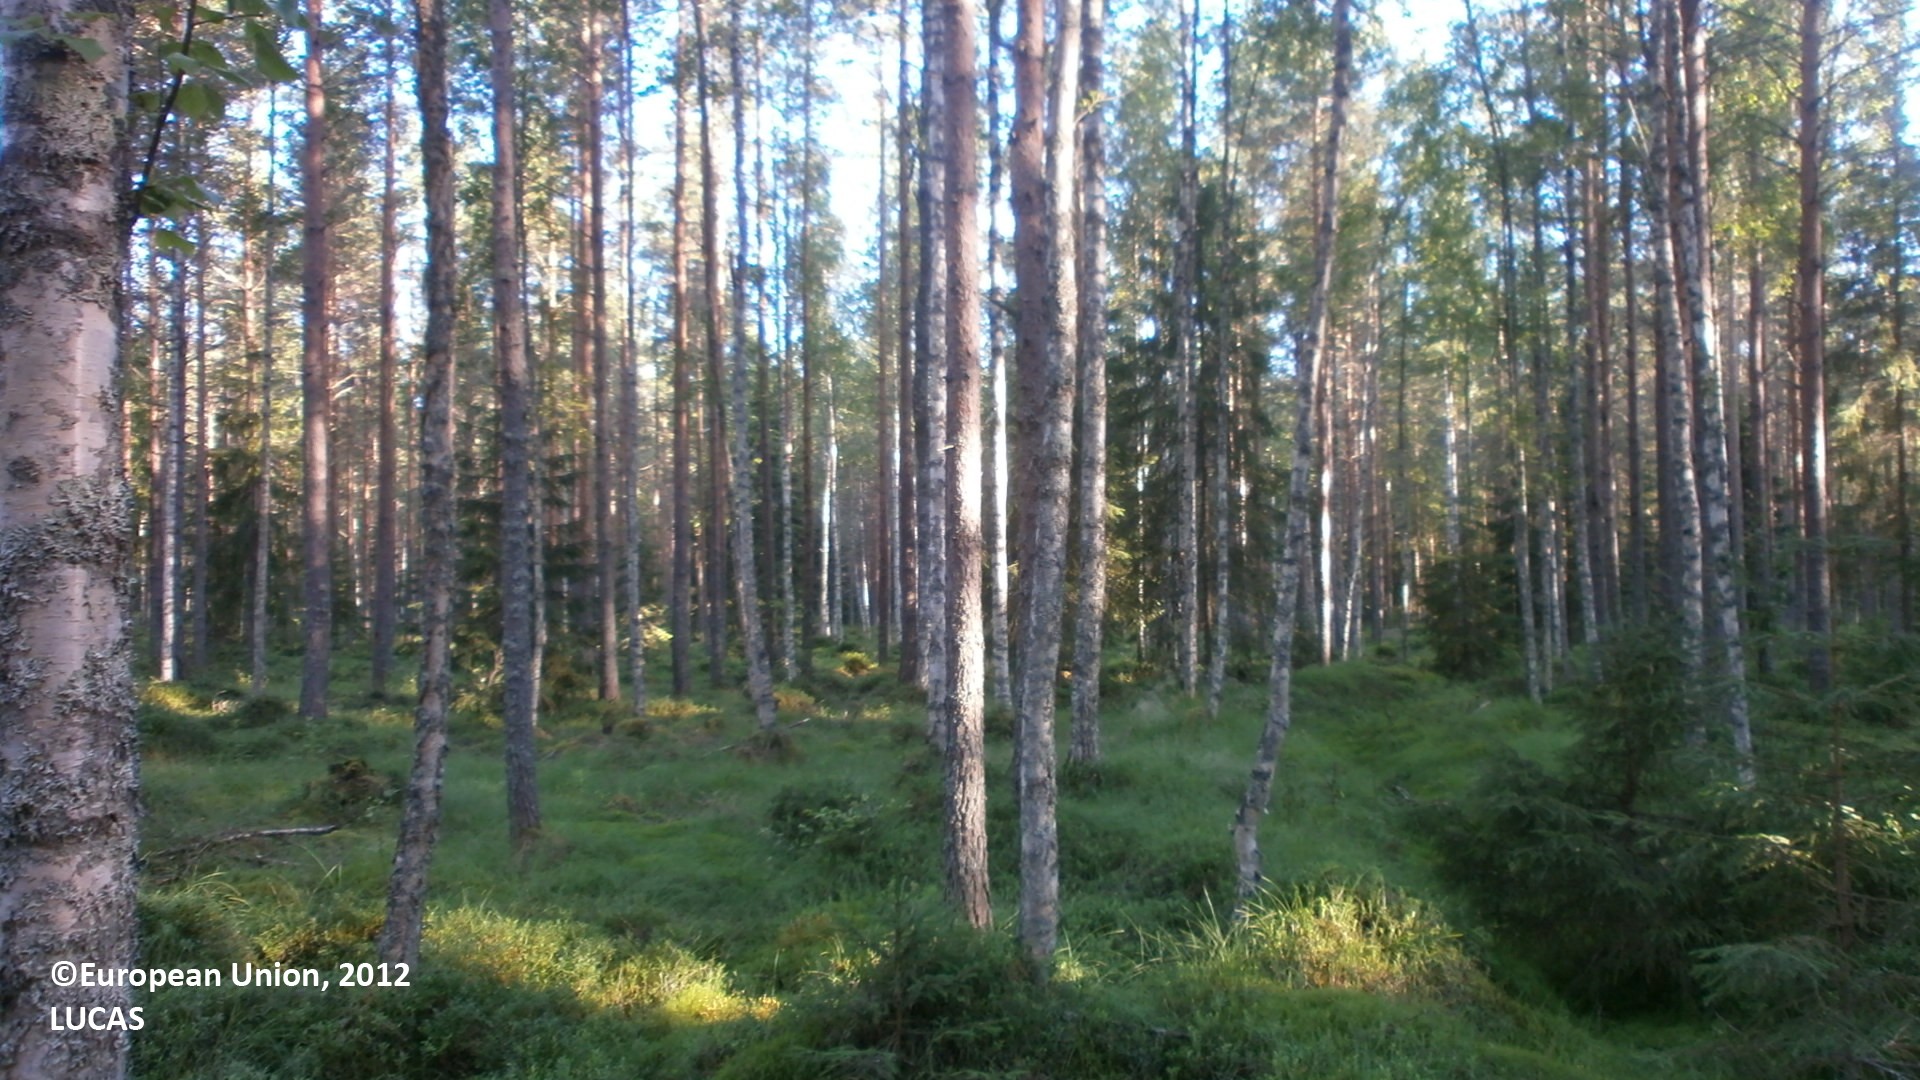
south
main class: Woodland
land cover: Pine dominated mixed woodland
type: boreal forest
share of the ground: 50 - 75 %
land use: Forestry
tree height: > 5 m
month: July
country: FI
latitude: 64.0484
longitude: 24.0129
